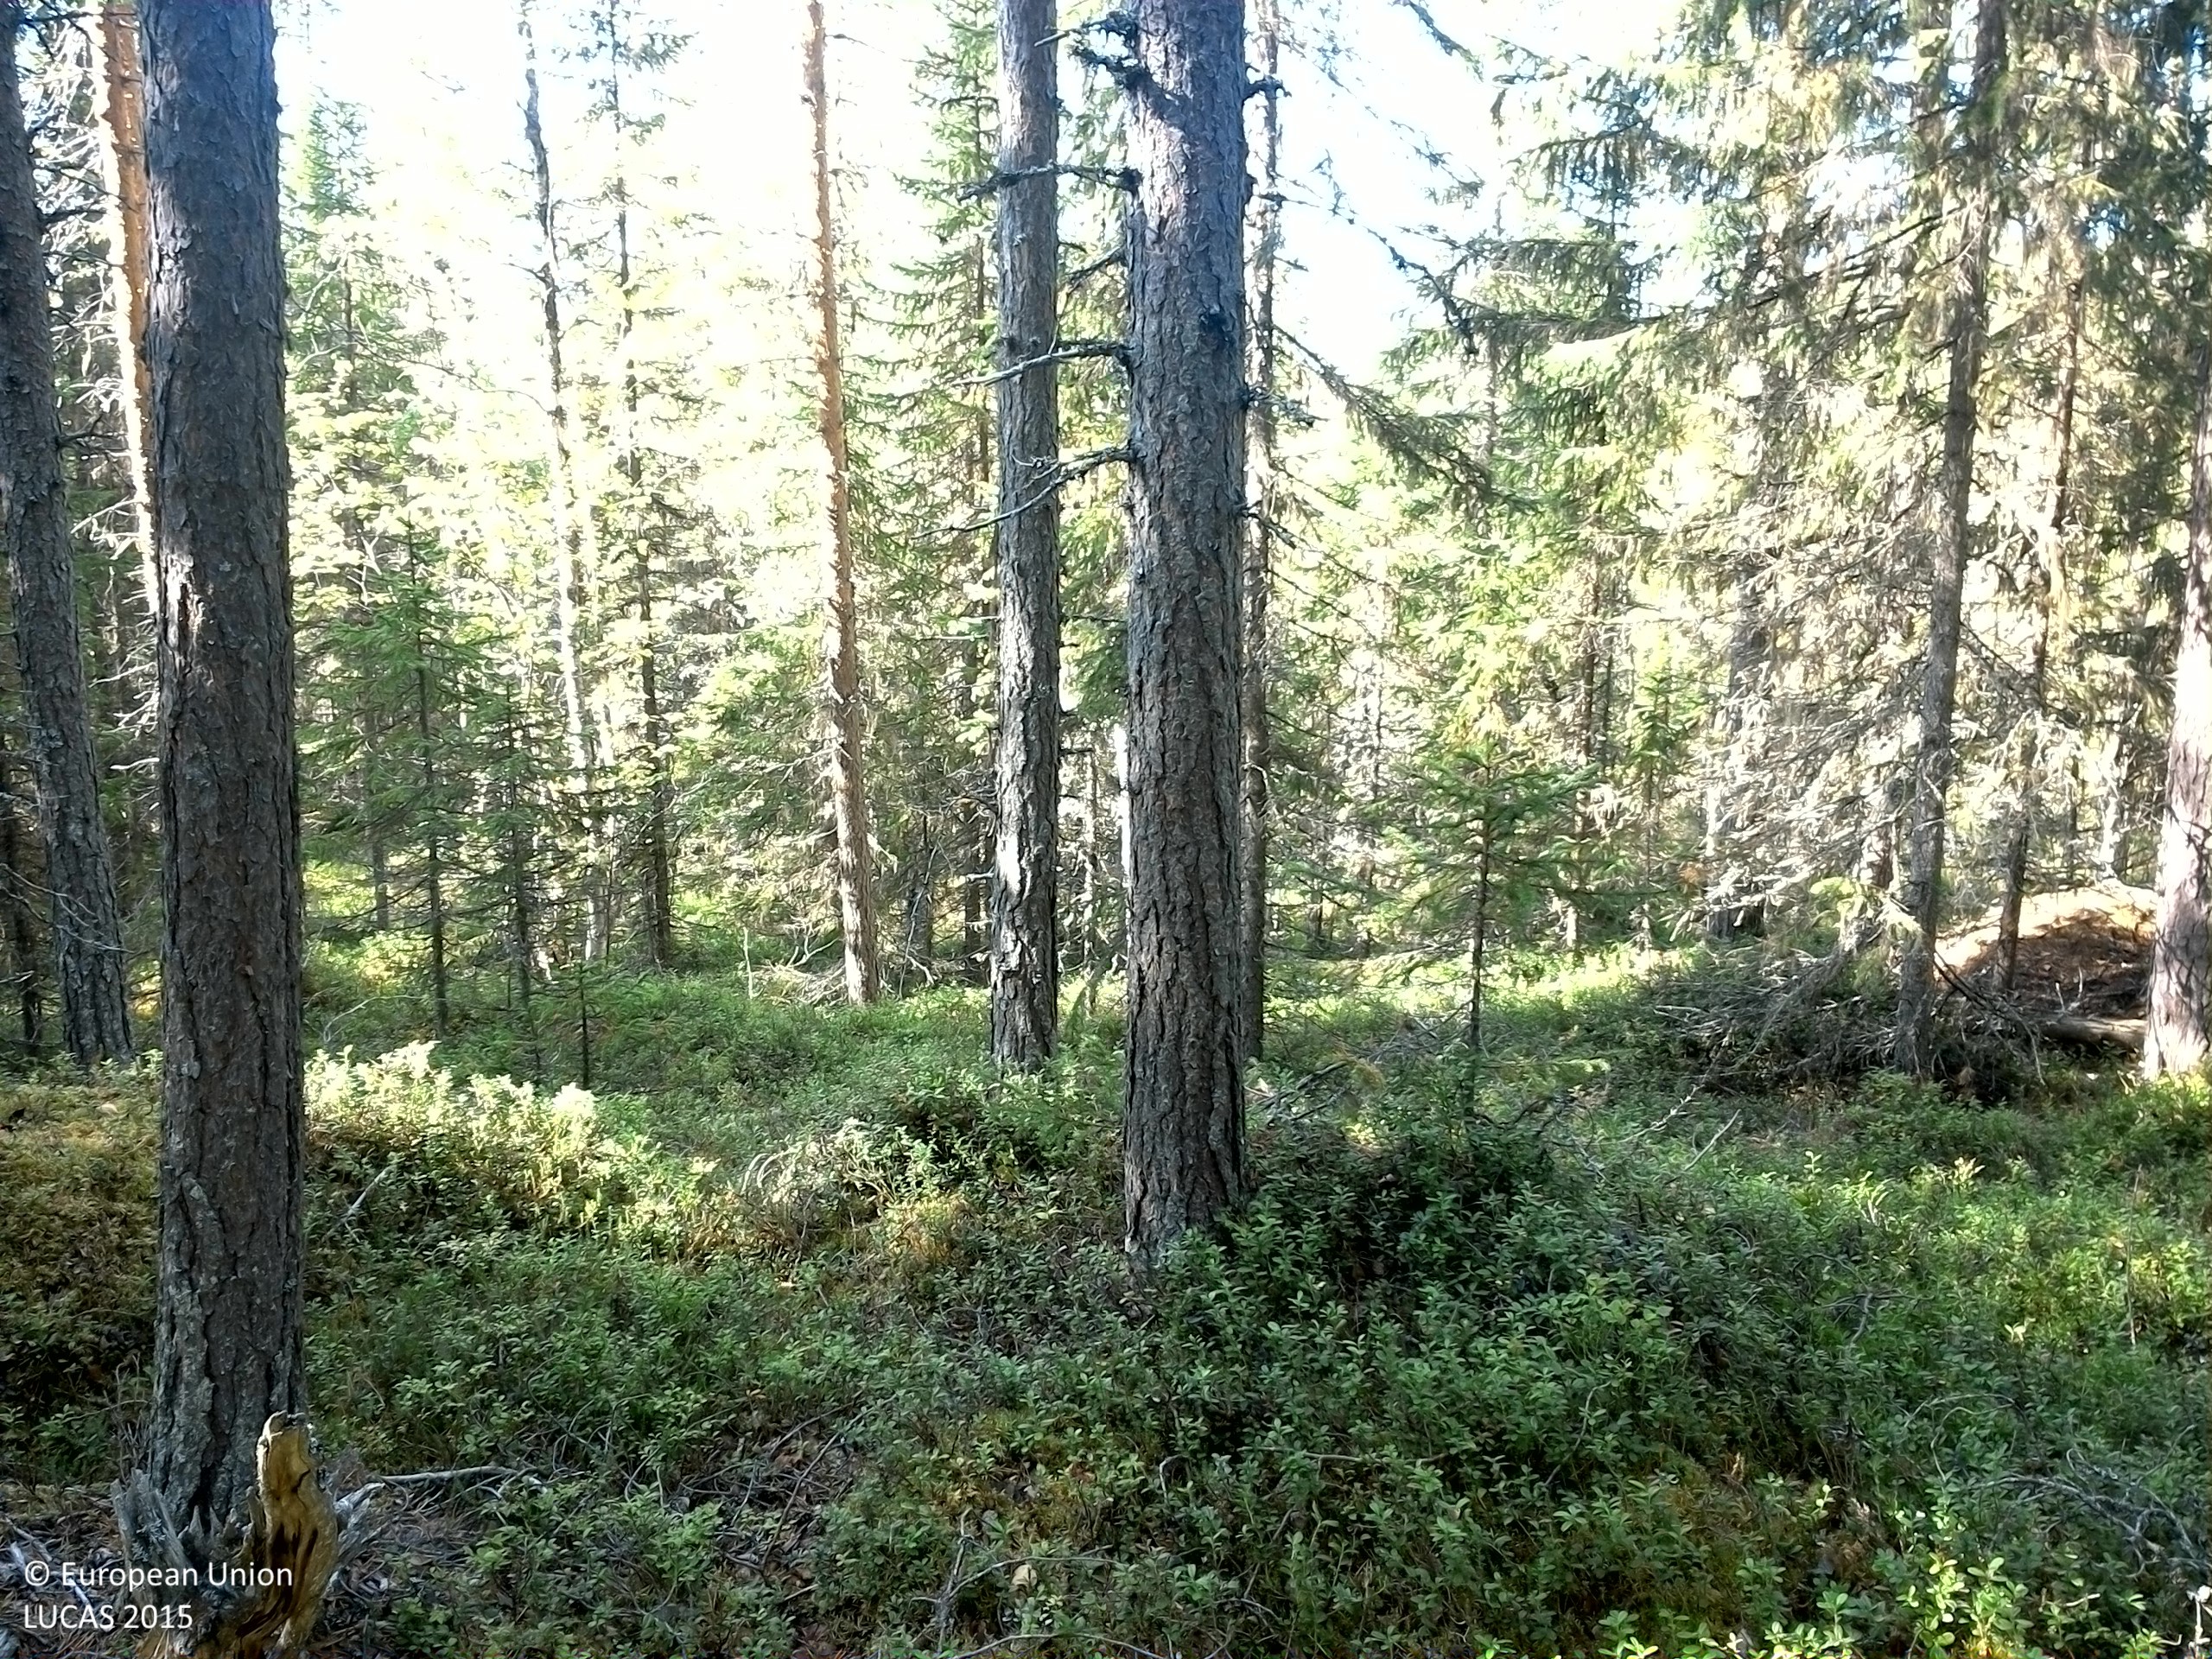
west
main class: Woodland
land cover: Spruce dominated coniferous woodland
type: boreal forest
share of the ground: 50 - 75 %
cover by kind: coniferous forest trees 60 %, shrubs 20 %, lichens and mosses 15 %, broadleaved forest trees 5 %
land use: Forestry
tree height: > 5 m
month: September
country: SE
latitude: 64.0490
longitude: 16.4633
